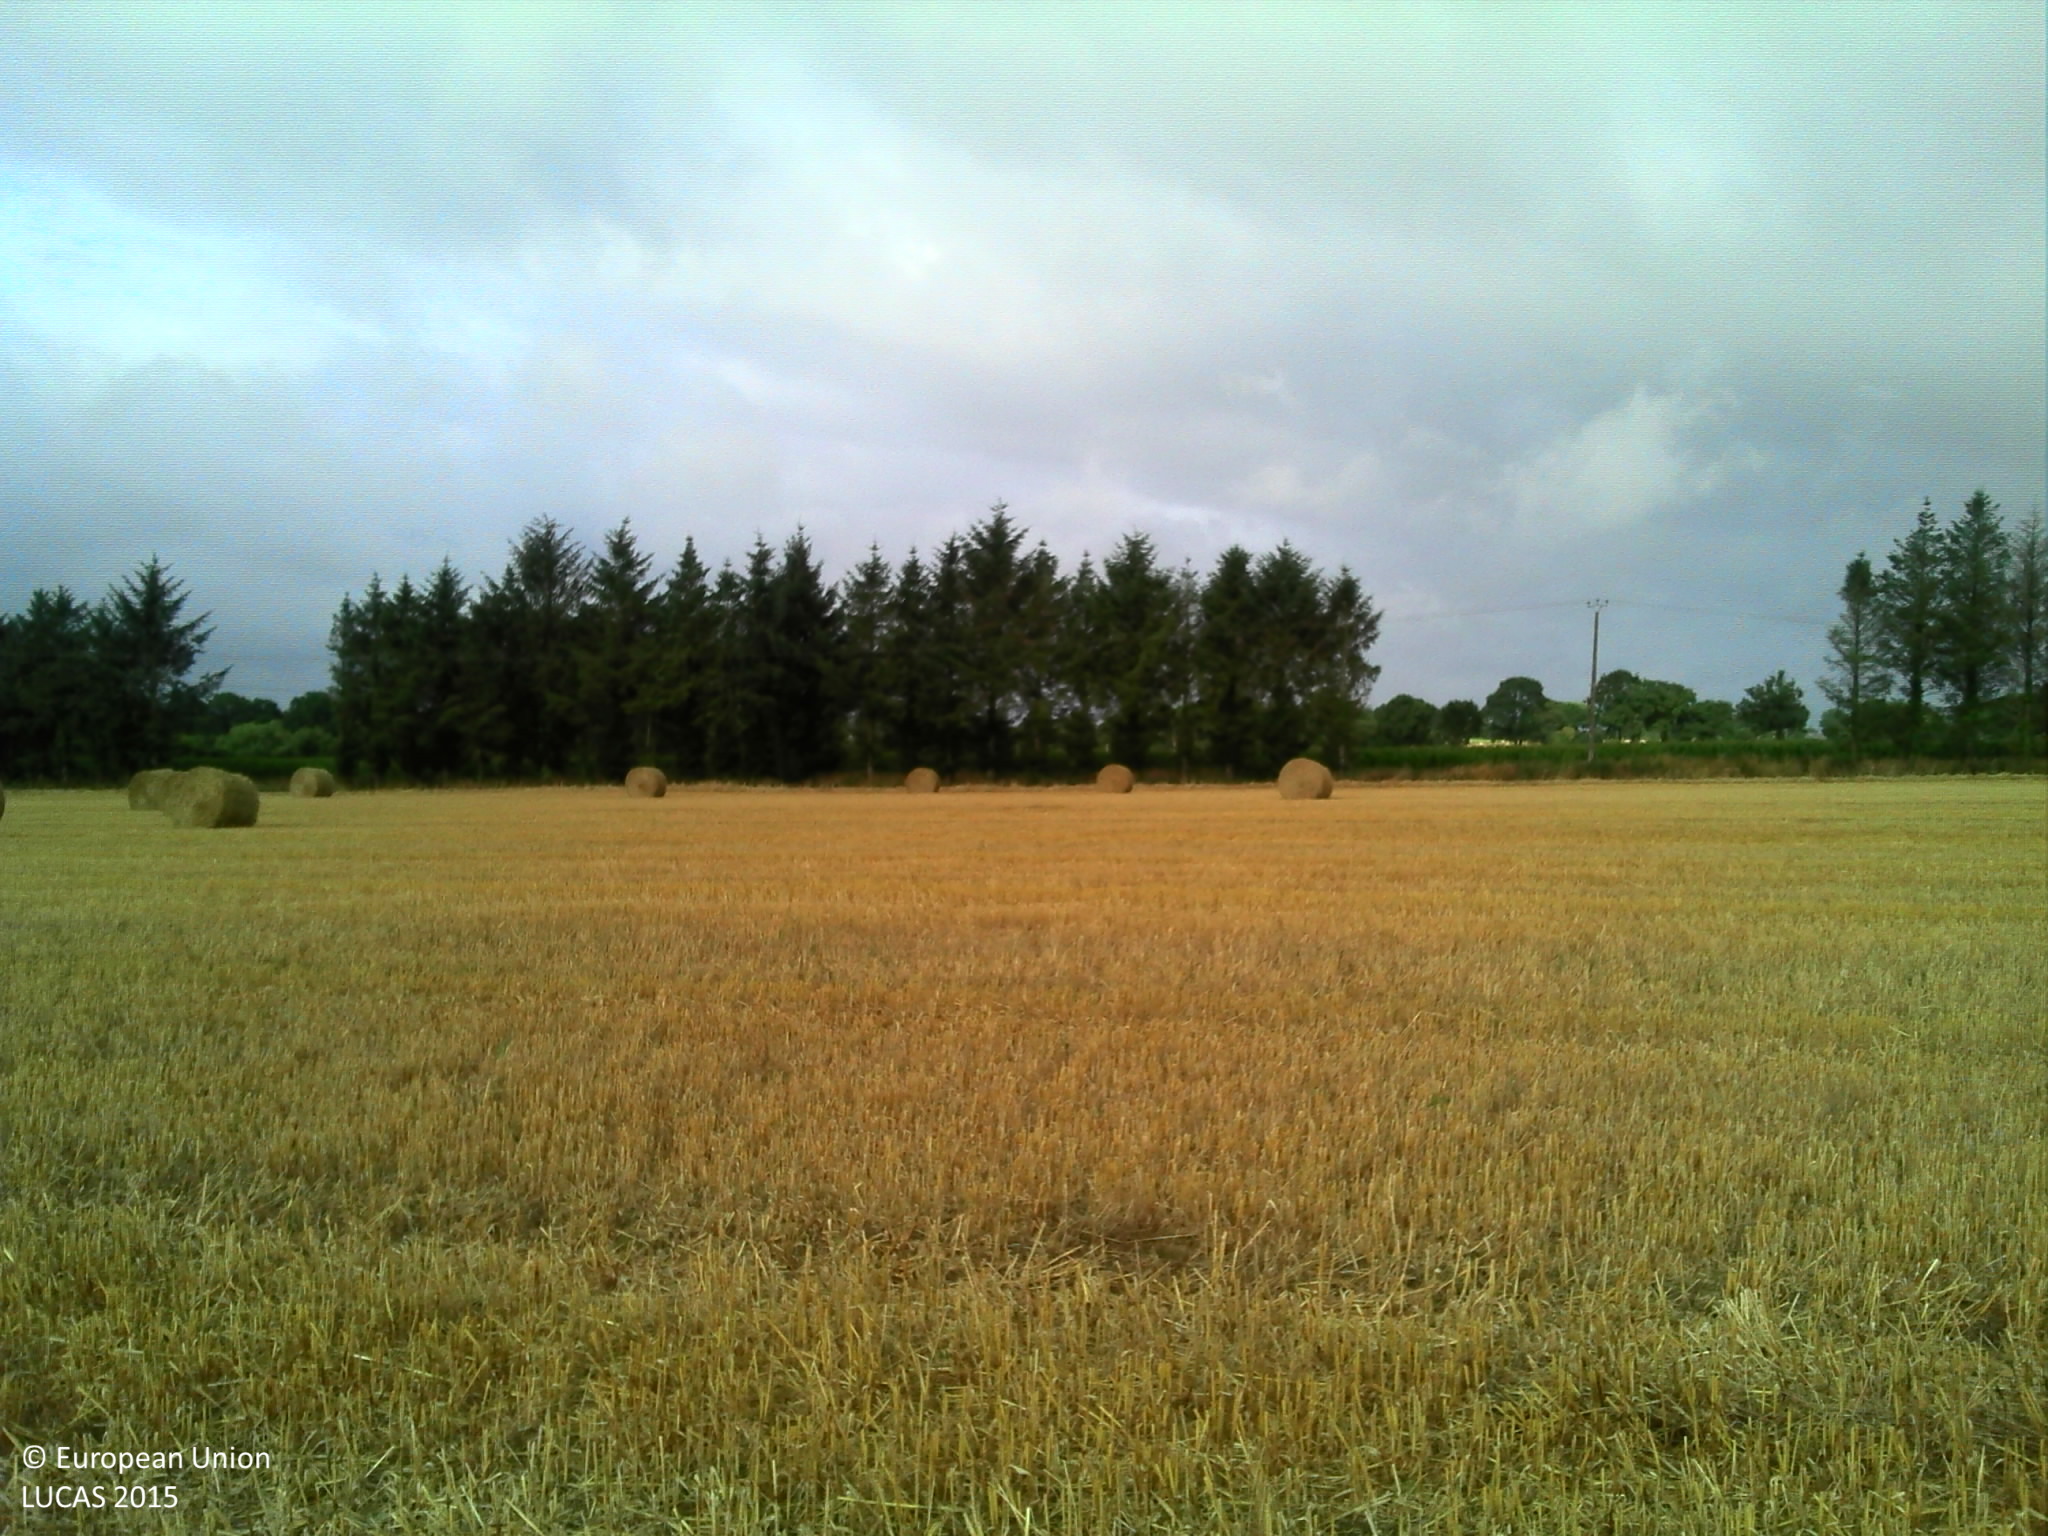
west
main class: Cropland
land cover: Common wheat
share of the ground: > 75 %
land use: Agriculture (excluding fallow land and kitchen gardens)
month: August
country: FR
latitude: 48.2824
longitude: -3.0474
